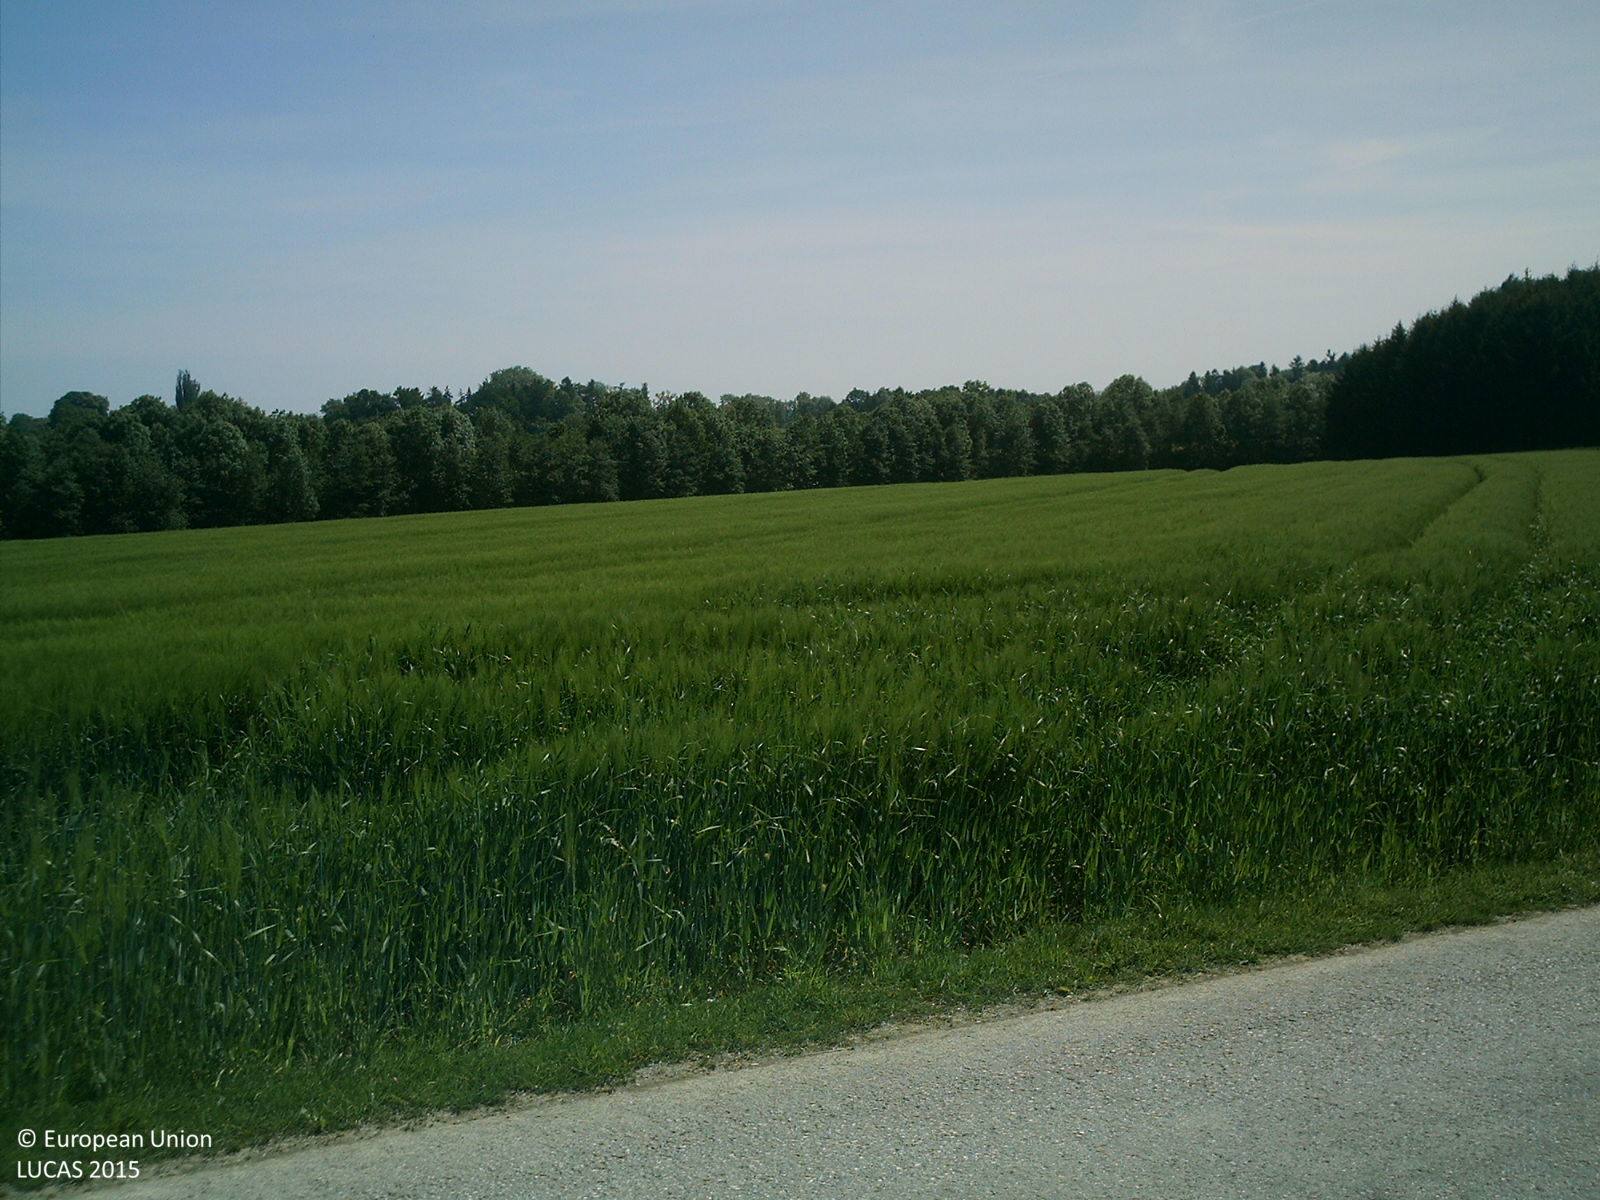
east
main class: Cropland
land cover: Maize
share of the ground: < 10 %
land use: Agriculture (excluding fallow land and kitchen gardens)
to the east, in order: Maize; Grass margins; Paved roads, cycling and walking lanes; Grass margins; Barley
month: May
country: AT
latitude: 47.9886
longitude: 14.0059
